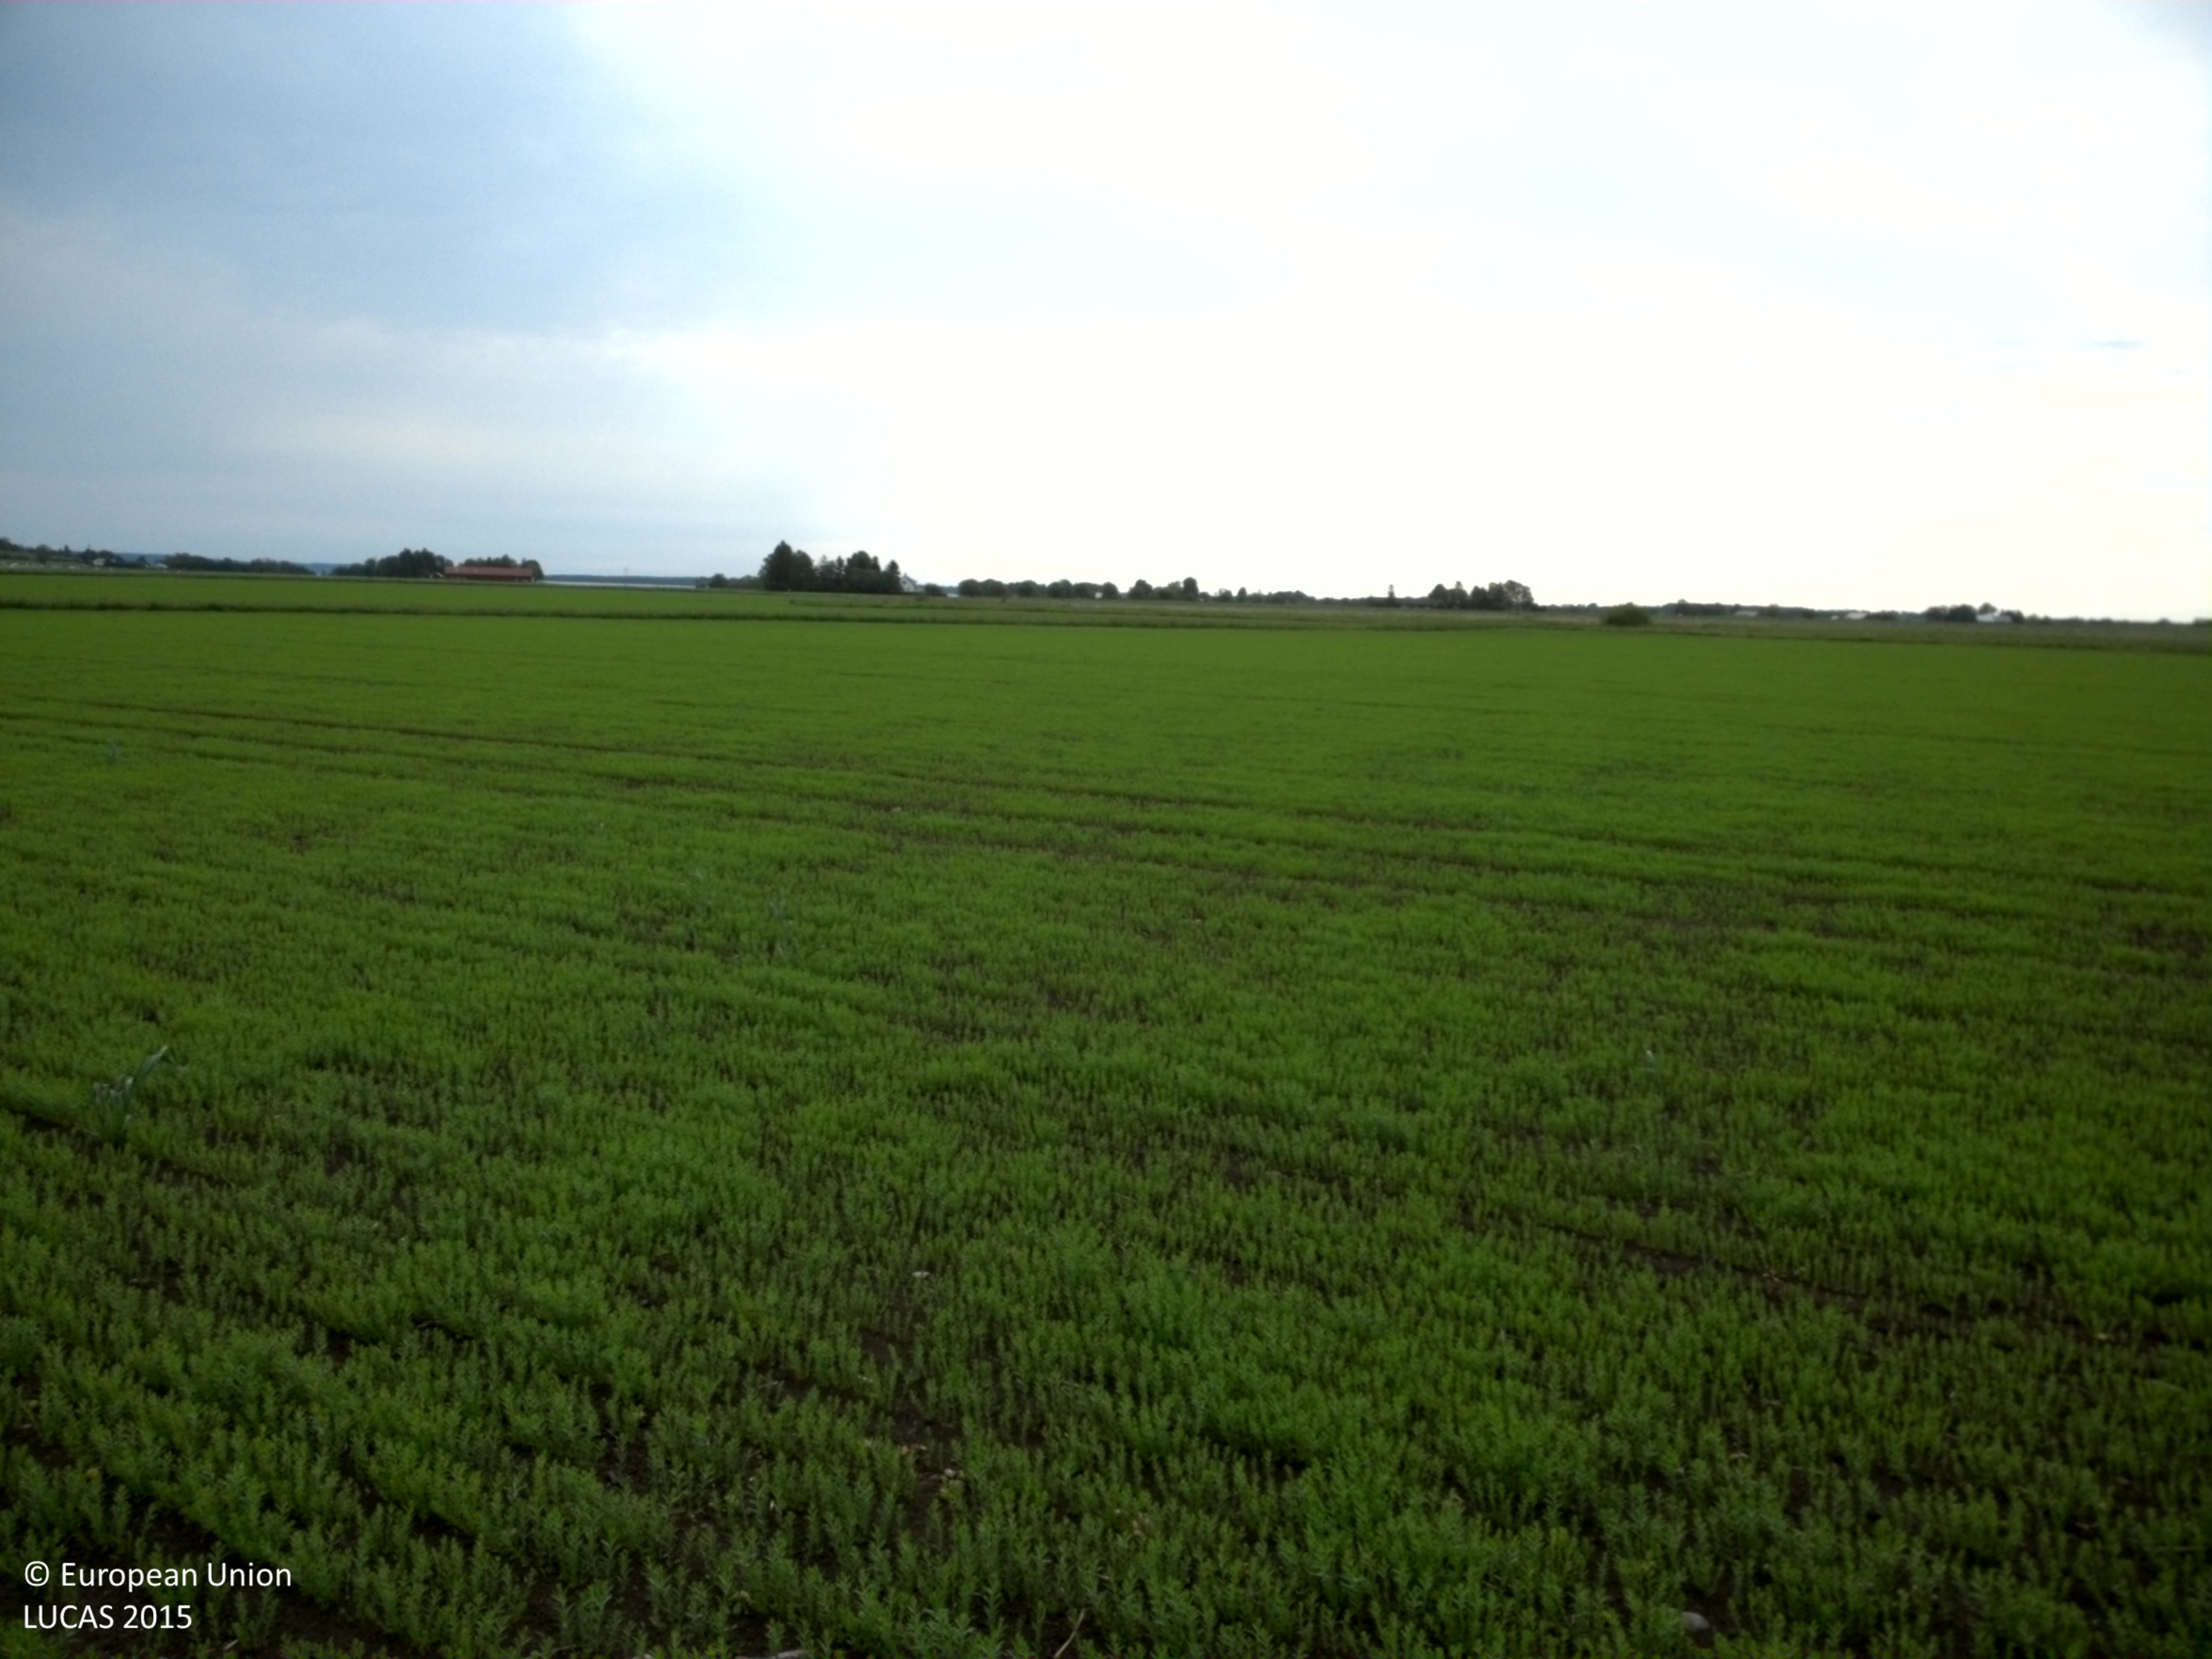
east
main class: Cropland
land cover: Other fibre and oleaginous crops
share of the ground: 10 - 25 %
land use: Agriculture (excluding fallow land and kitchen gardens)
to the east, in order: Other fibre and oleaginous crops; Paved roads, cycling and walking lanes; Oats; Grass margins; Tracks; Grass margins; Ditches and canals; Spontaneously vegetated surfaces
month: June
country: SE
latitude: 58.4678
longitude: 15.4973
